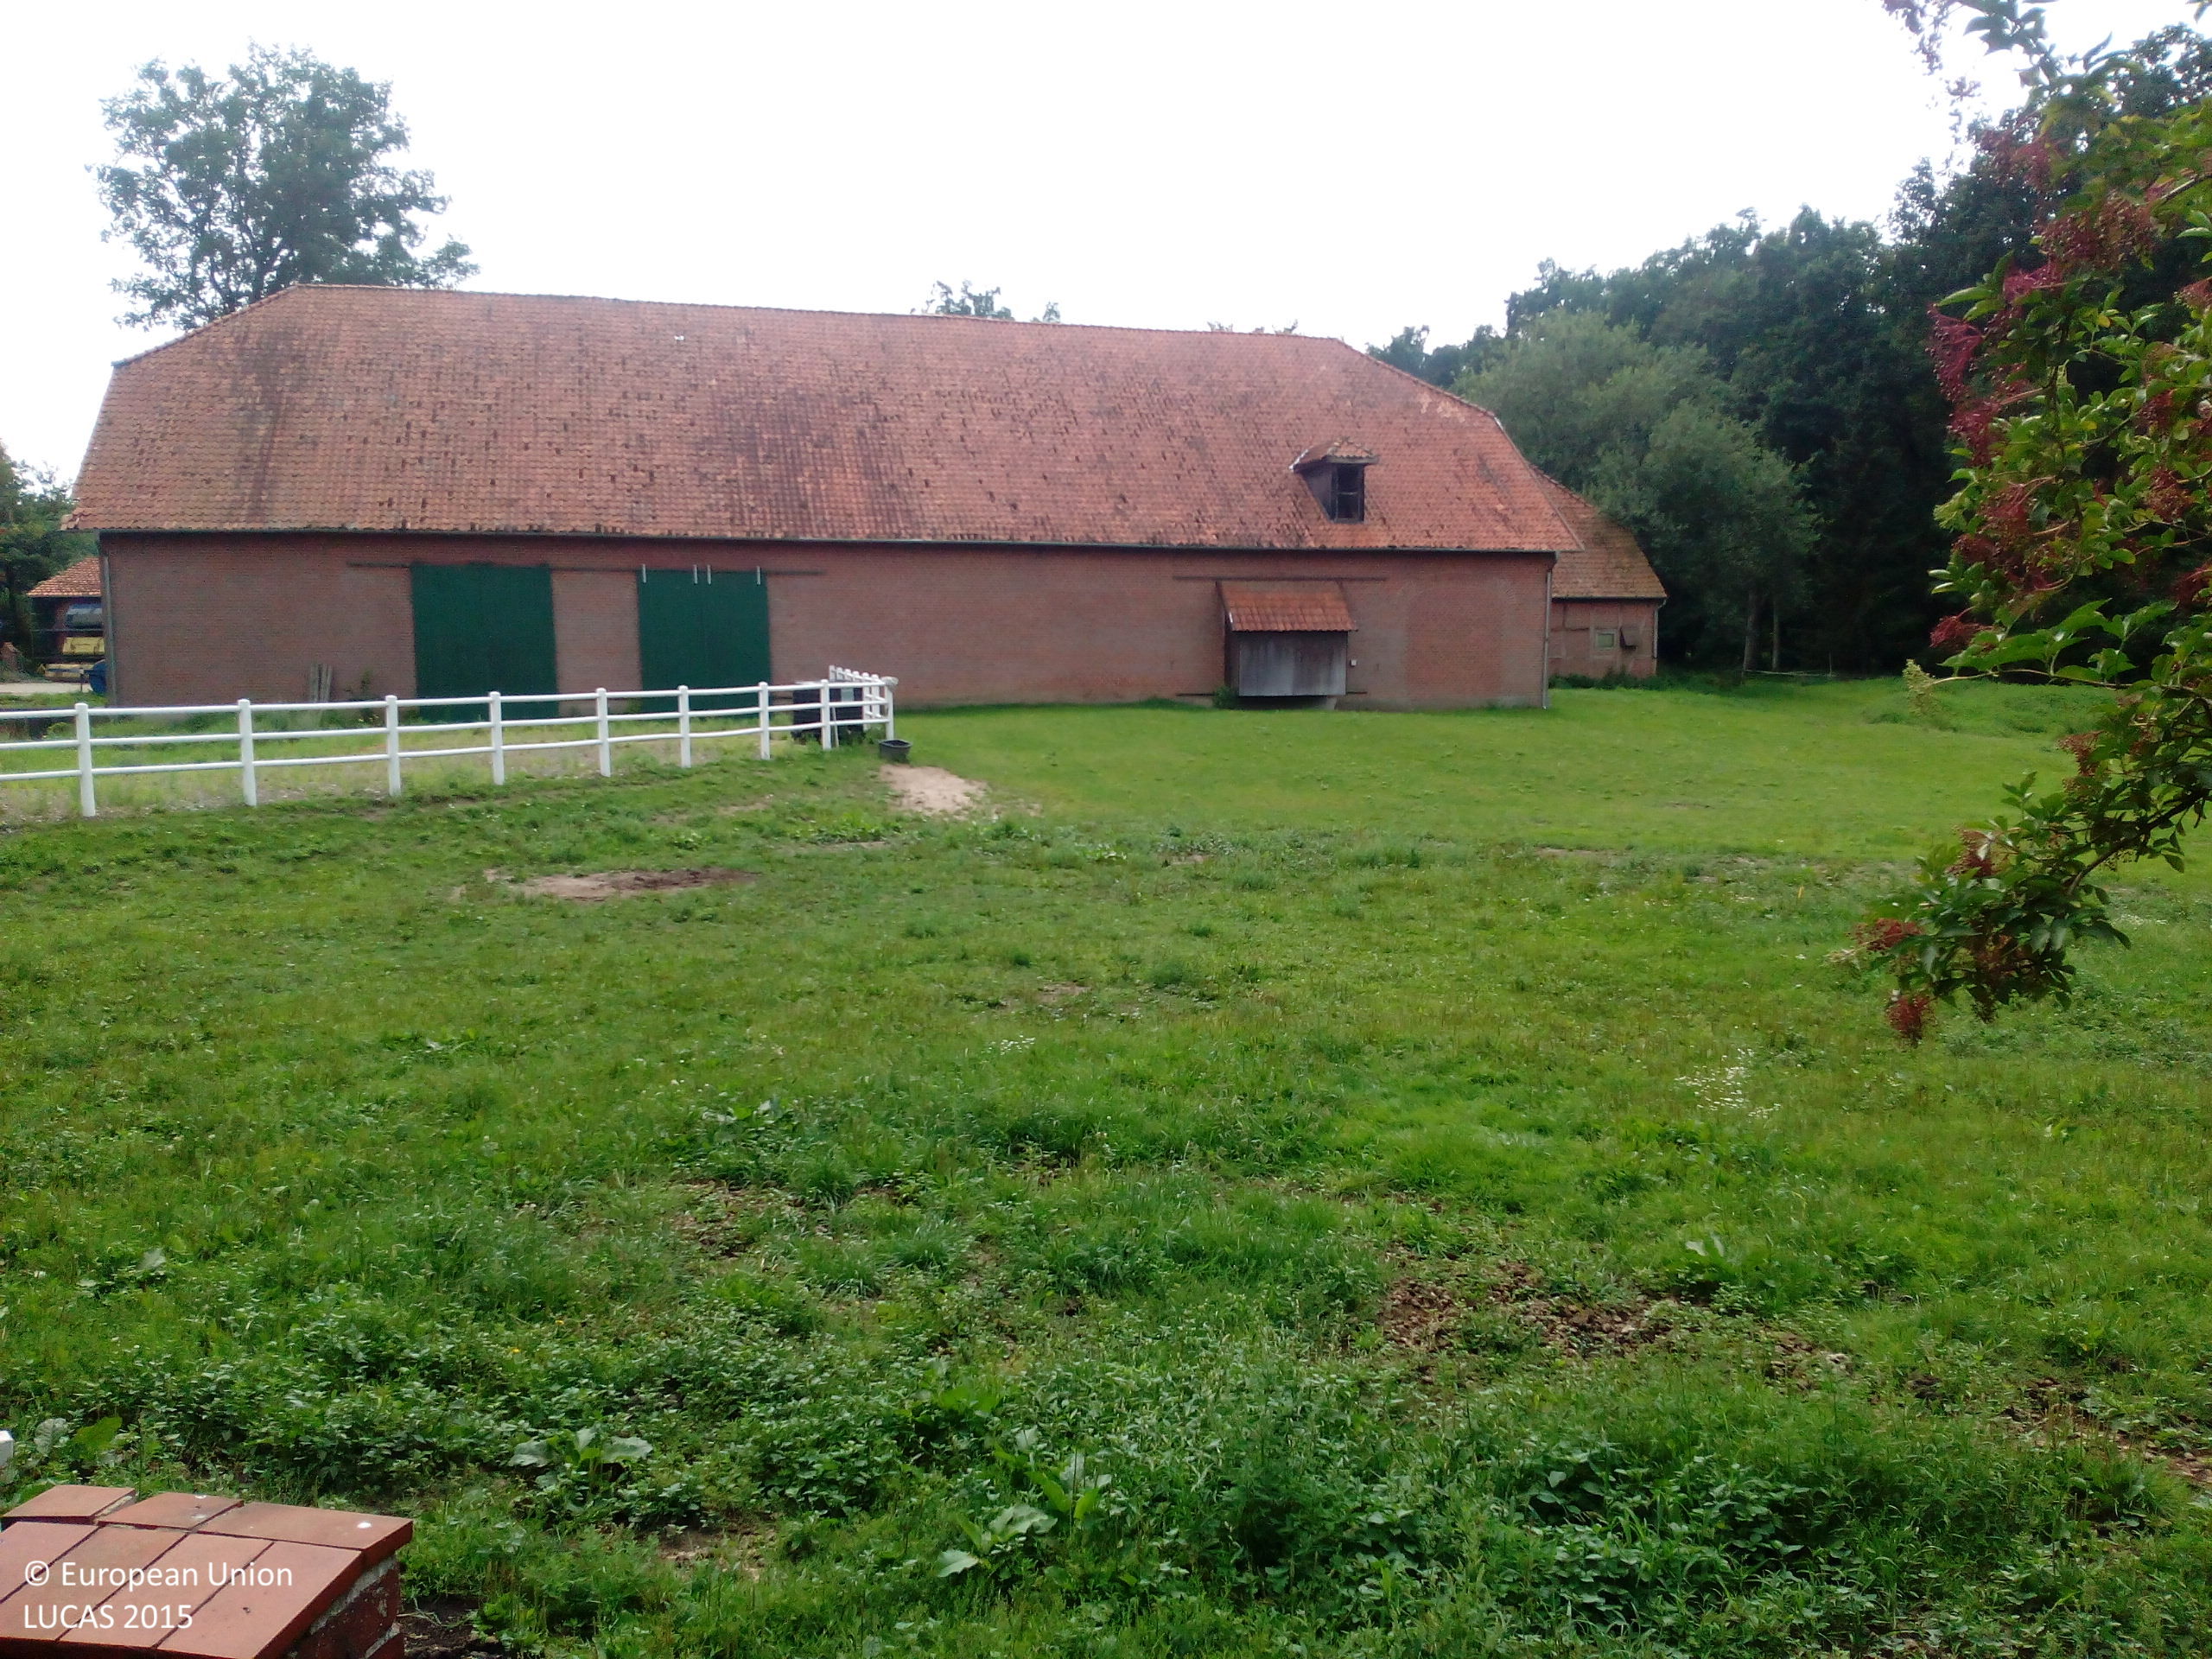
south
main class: Woodland
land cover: Broadleaved woodland
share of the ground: 25 - 50 %
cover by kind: herbaceous plants 55 %, broadleaved forest trees 30 %, shrubs 15 %
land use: Community services
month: August
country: DE
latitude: 52.9870
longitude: 10.6105
